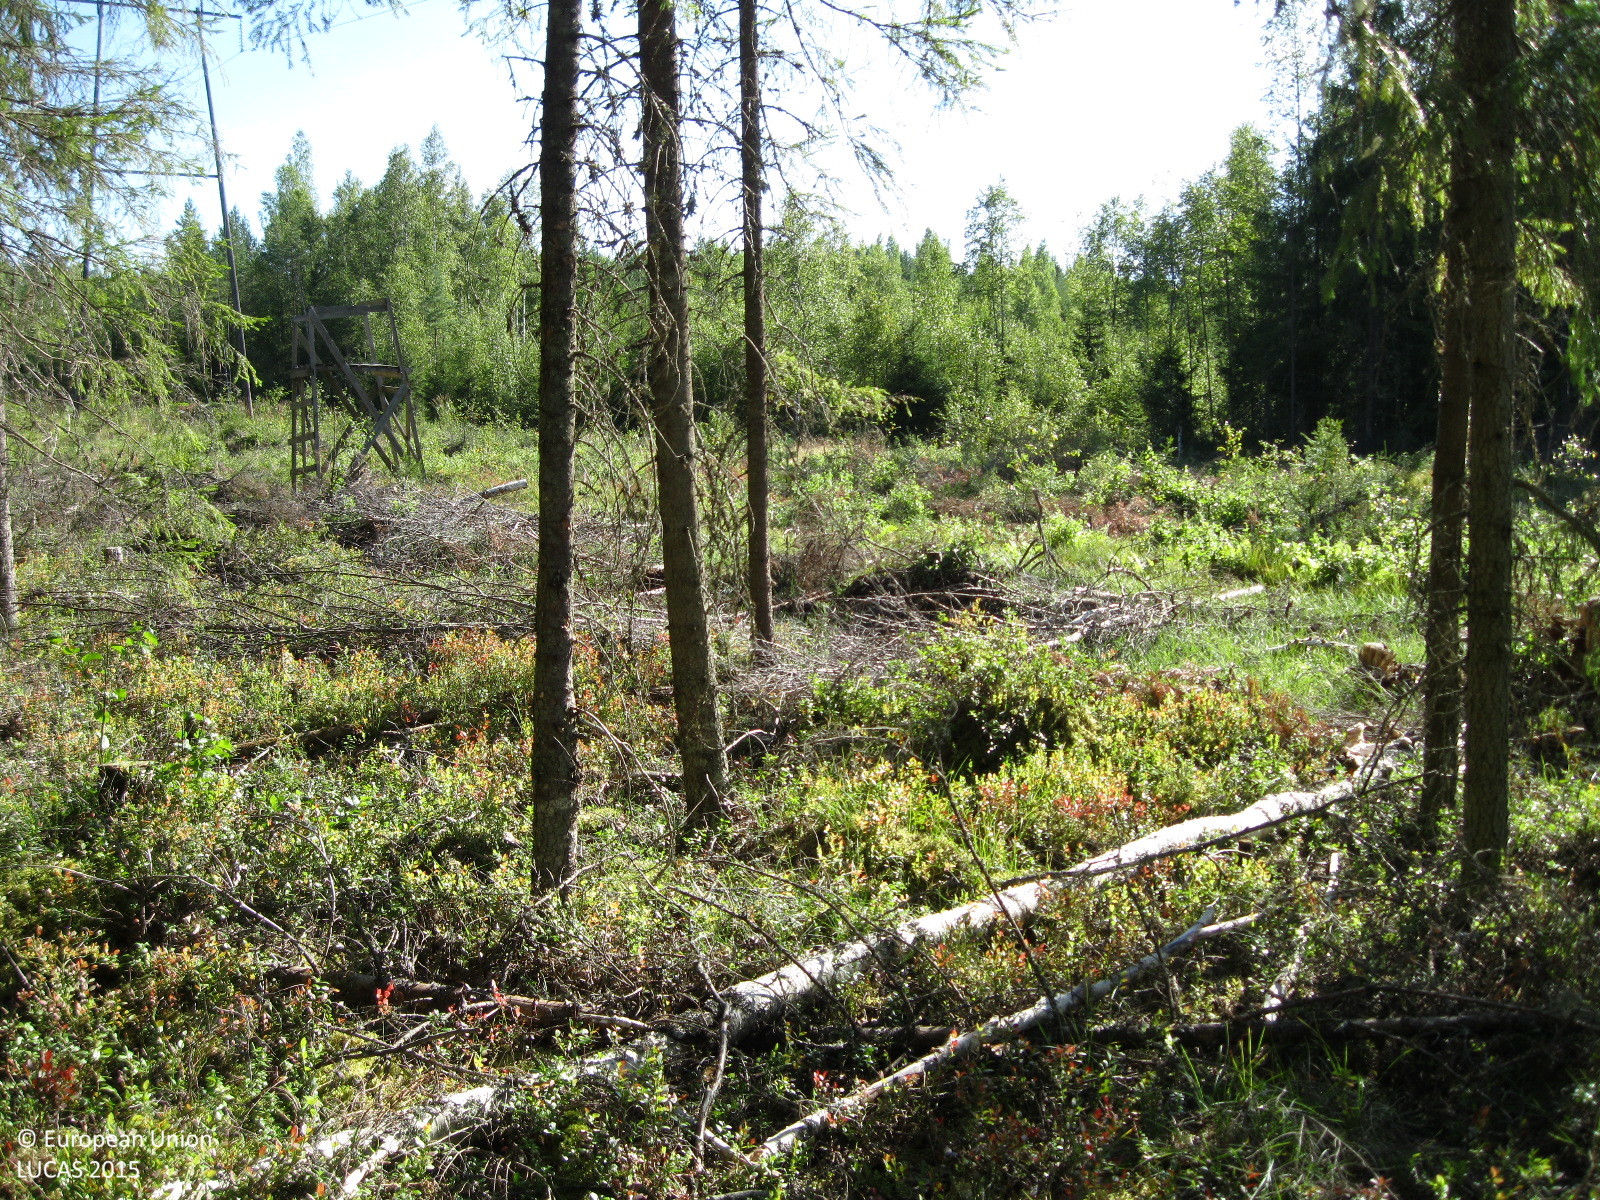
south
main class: Woodland
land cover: Other mixed woodland
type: boreal forest
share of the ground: > 75 %
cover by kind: coniferous forest trees 55 %, broadleaved forest trees 30 %, shrubs 15 %
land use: Forestry
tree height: > 5 m
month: August
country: FI
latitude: 61.2552
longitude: 25.2725
